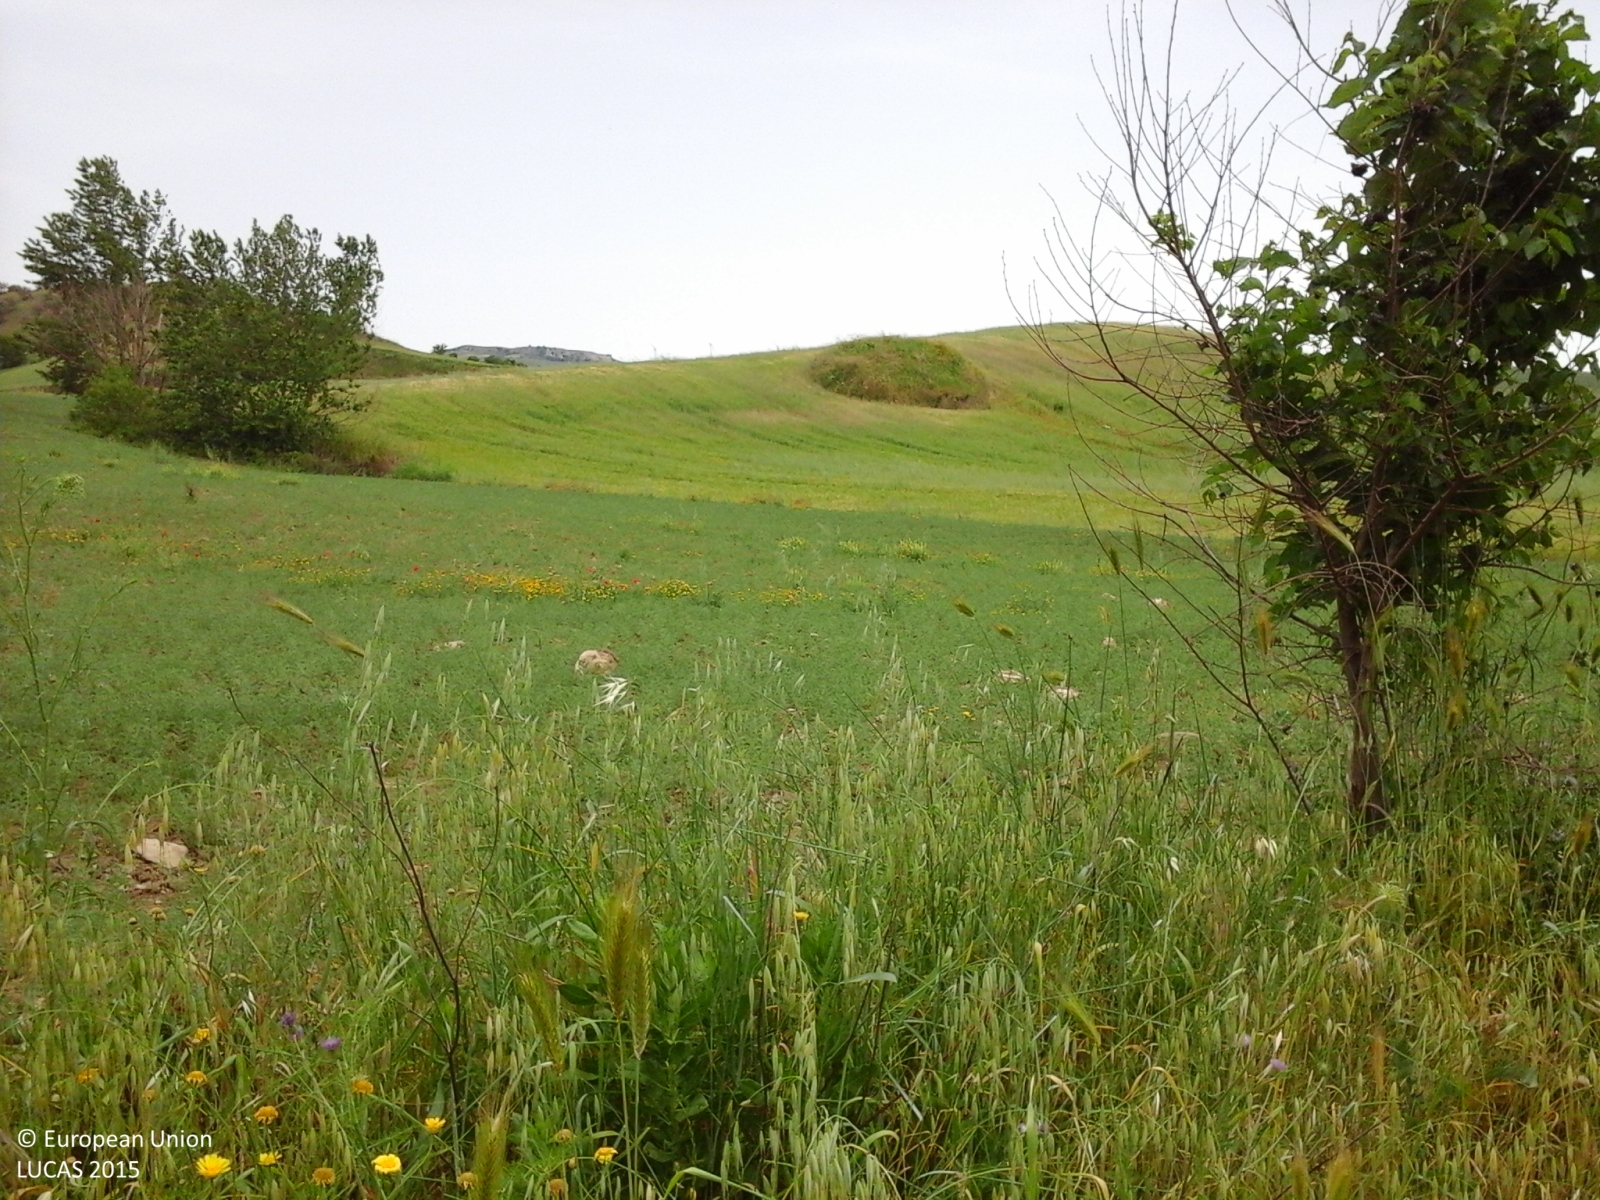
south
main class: Grassland
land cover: Spontaneously vegetated surfaces
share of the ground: > 75 %
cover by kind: herbaceous plants 100 %
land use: Agriculture (excluding fallow land and kitchen gardens)
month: May
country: IT
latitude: 37.6645
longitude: 13.9727
